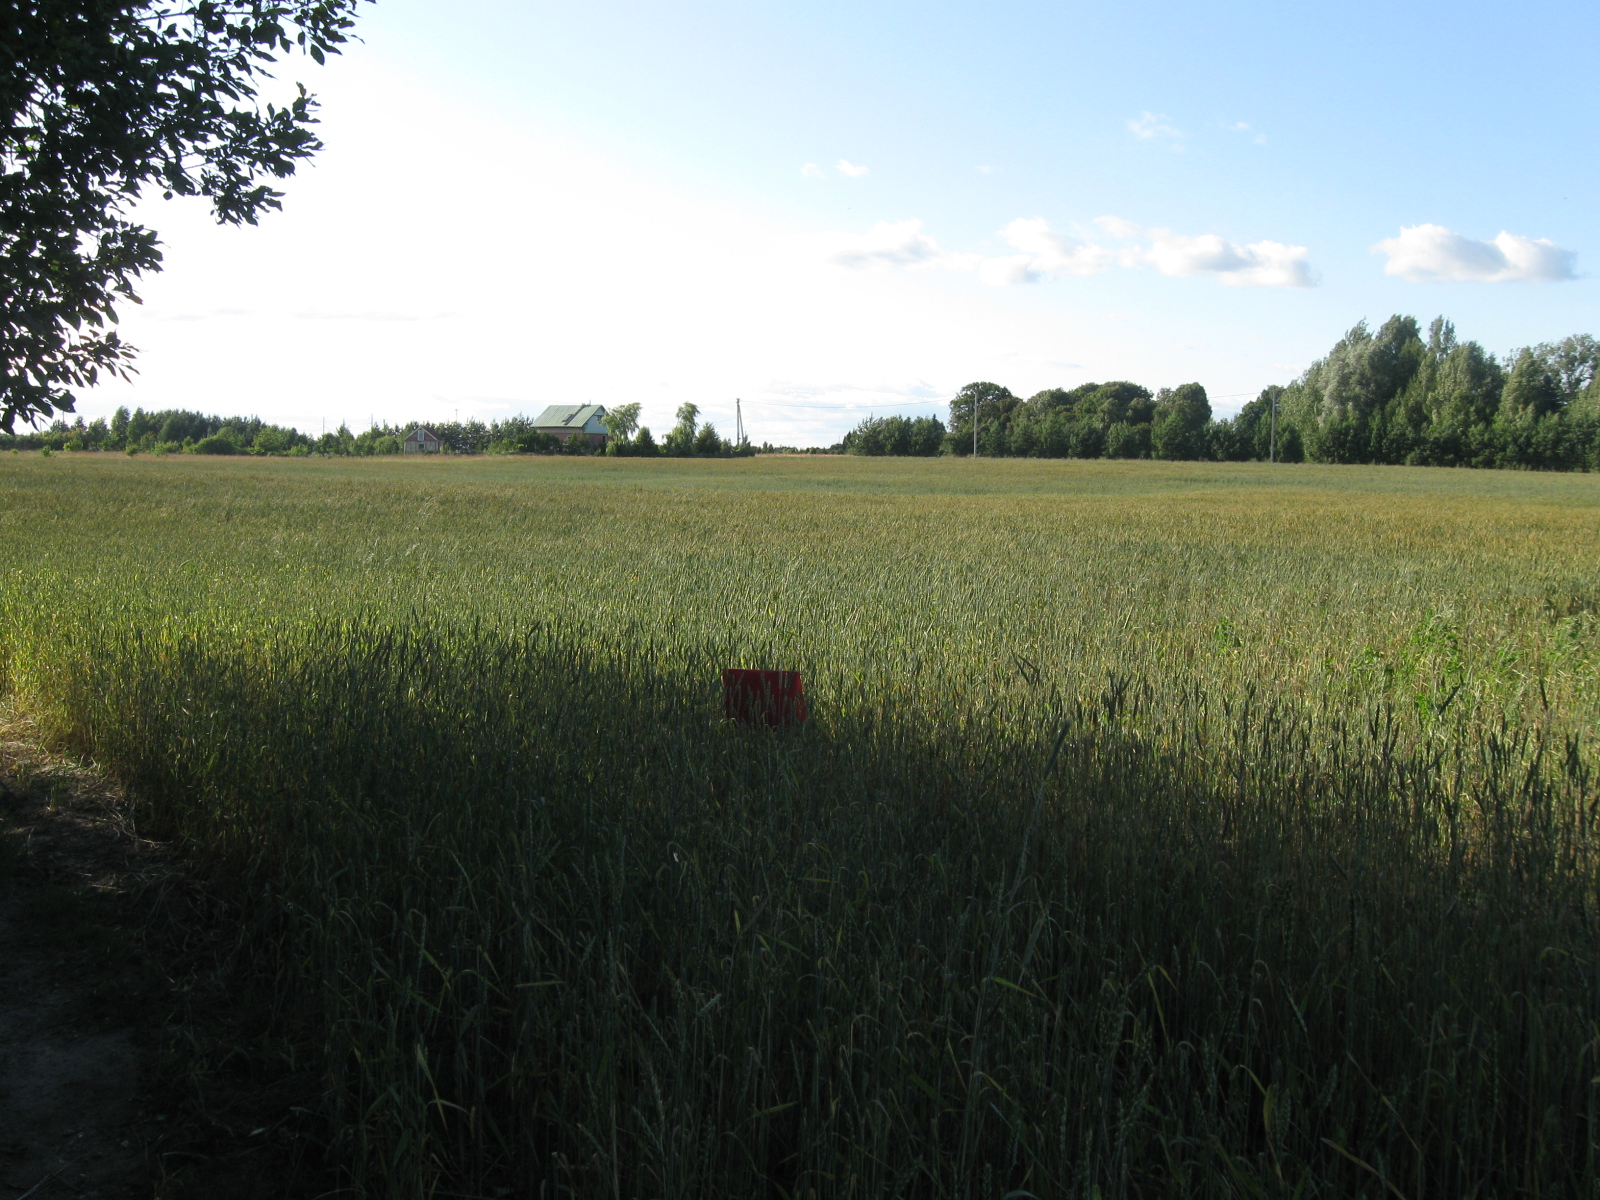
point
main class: Cropland
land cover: Common wheat
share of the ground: > 75 %
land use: Agriculture (excluding fallow land and kitchen gardens)
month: July
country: LT
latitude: 54.8726
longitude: 23.7846
